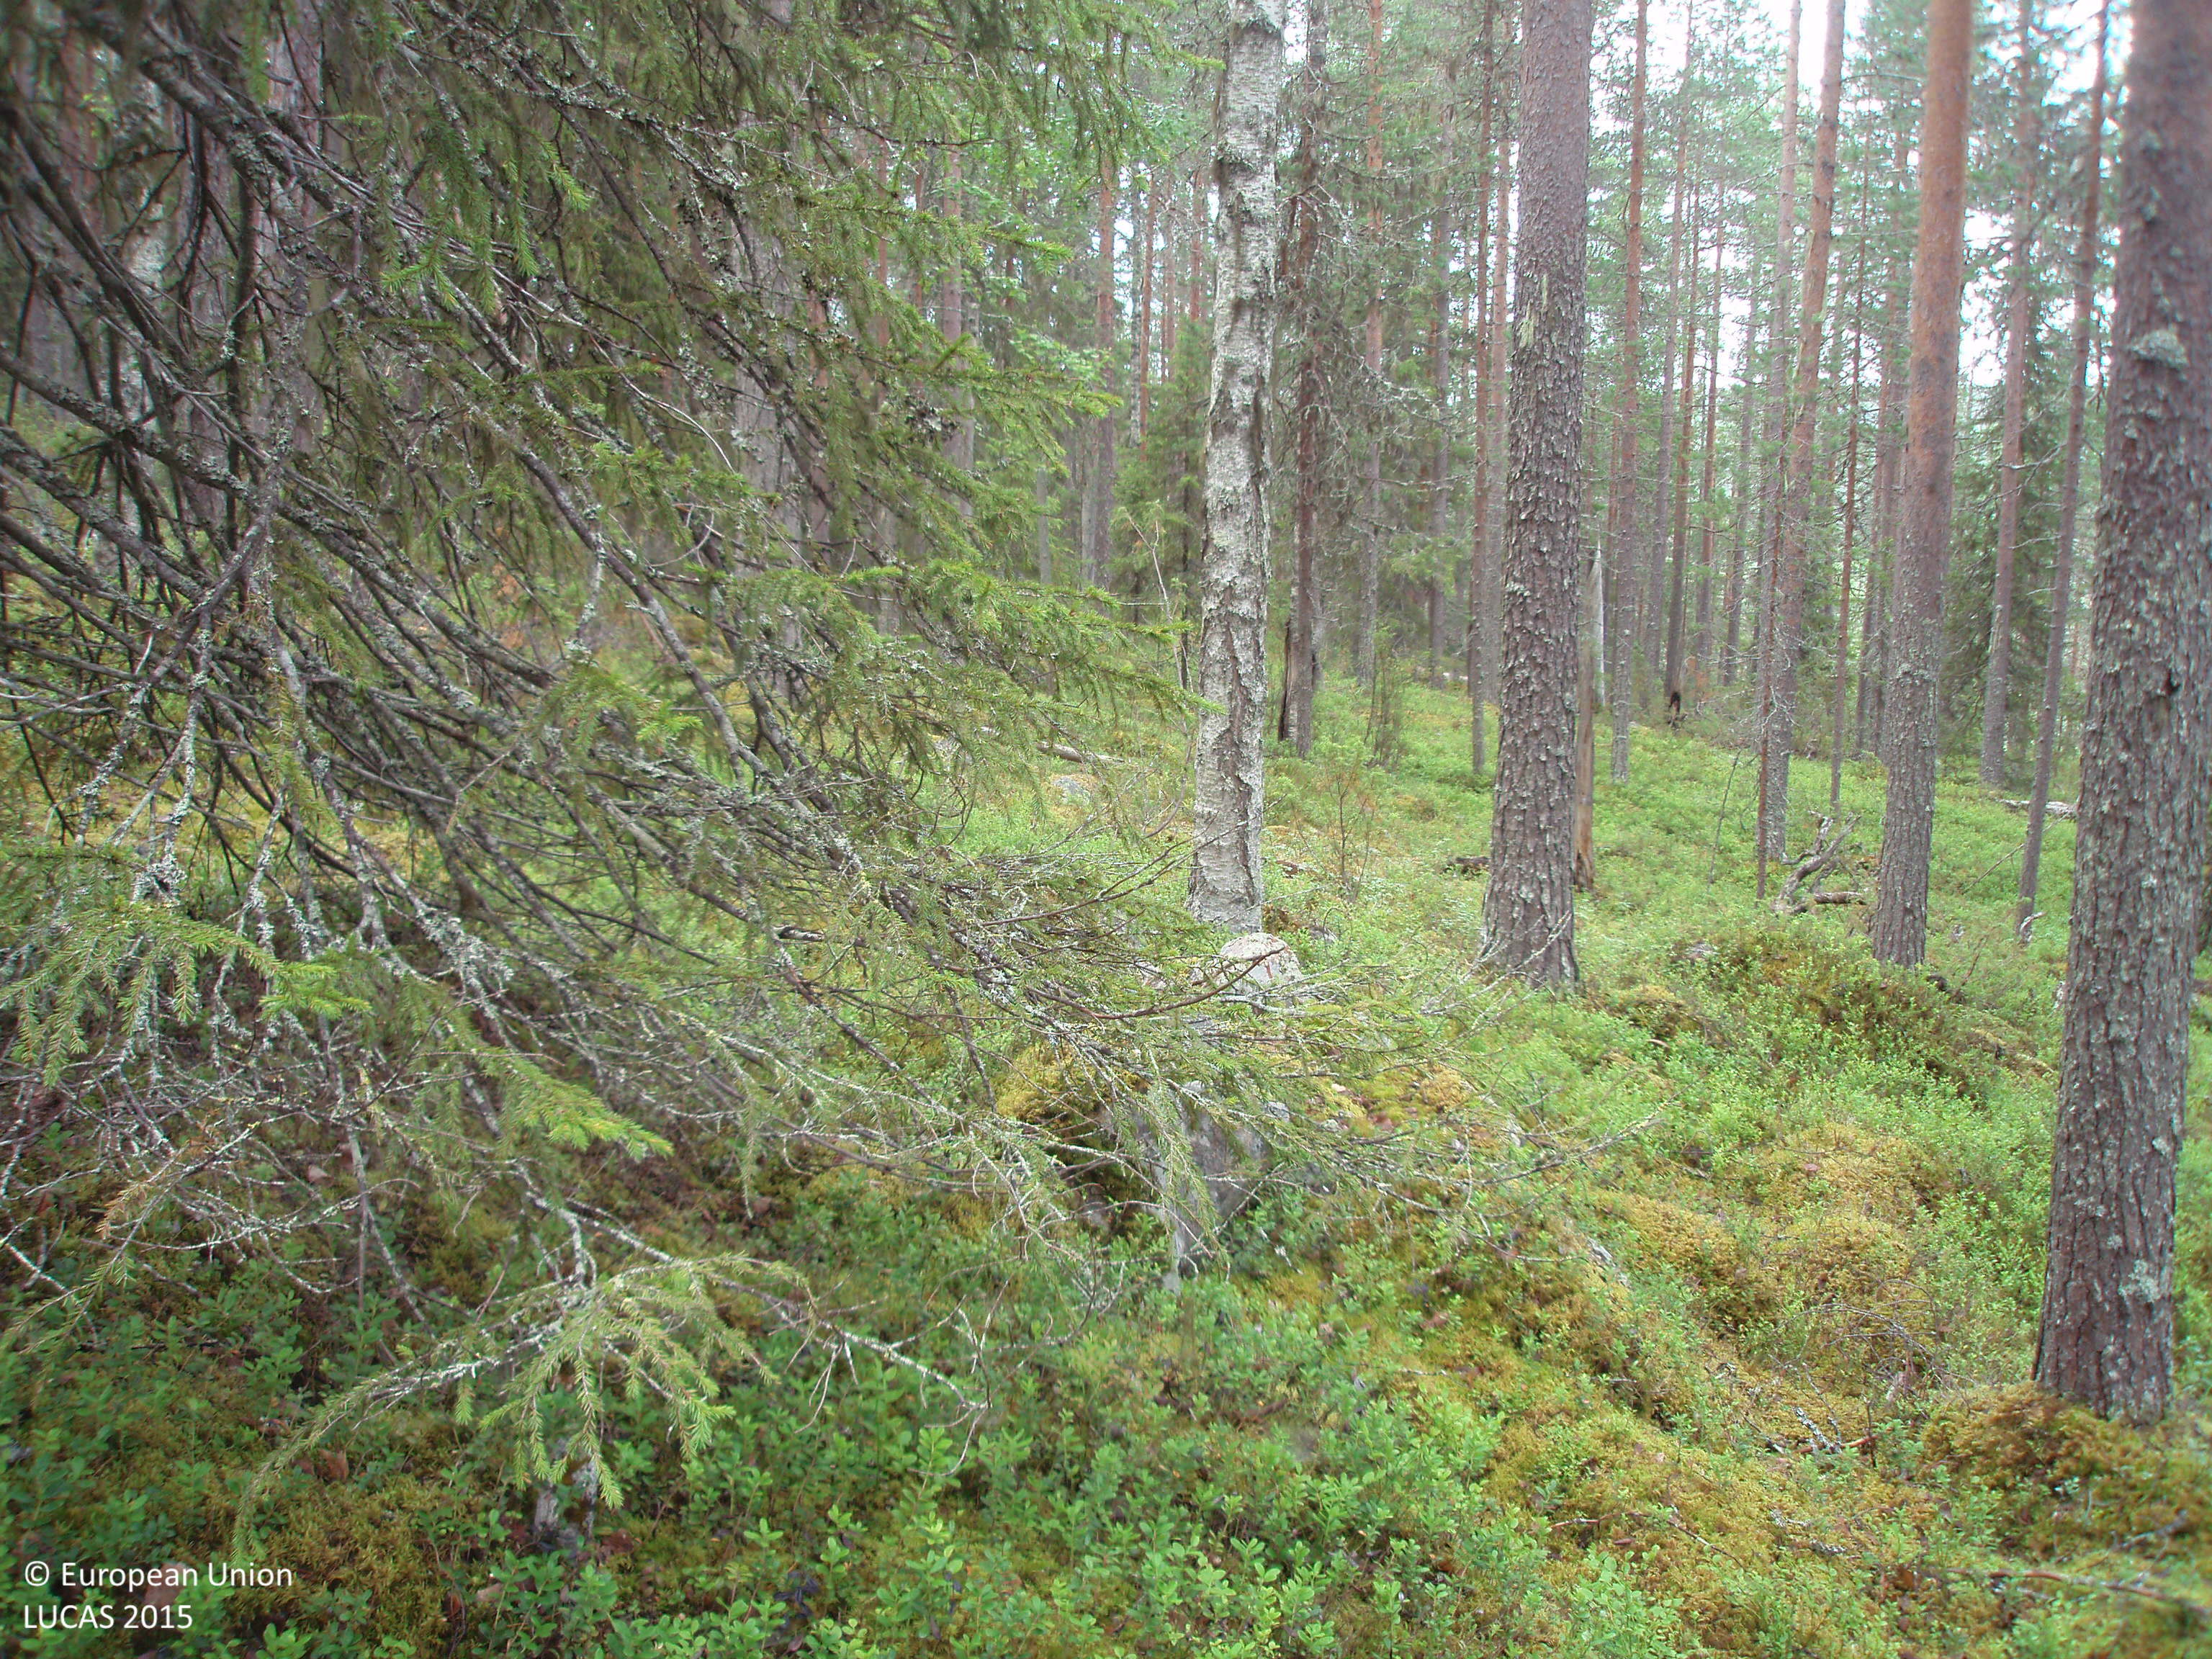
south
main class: Woodland
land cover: Other coniferous woodland
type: boreal forest
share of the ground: 50 - 75 %
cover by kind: coniferous forest trees 55 %, shrubs 30 %, broadleaved forest trees 15 %
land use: Semi-natural and natural areas not in use
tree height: > 5 m
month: August
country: FI
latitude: 65.5491
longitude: 27.3817
